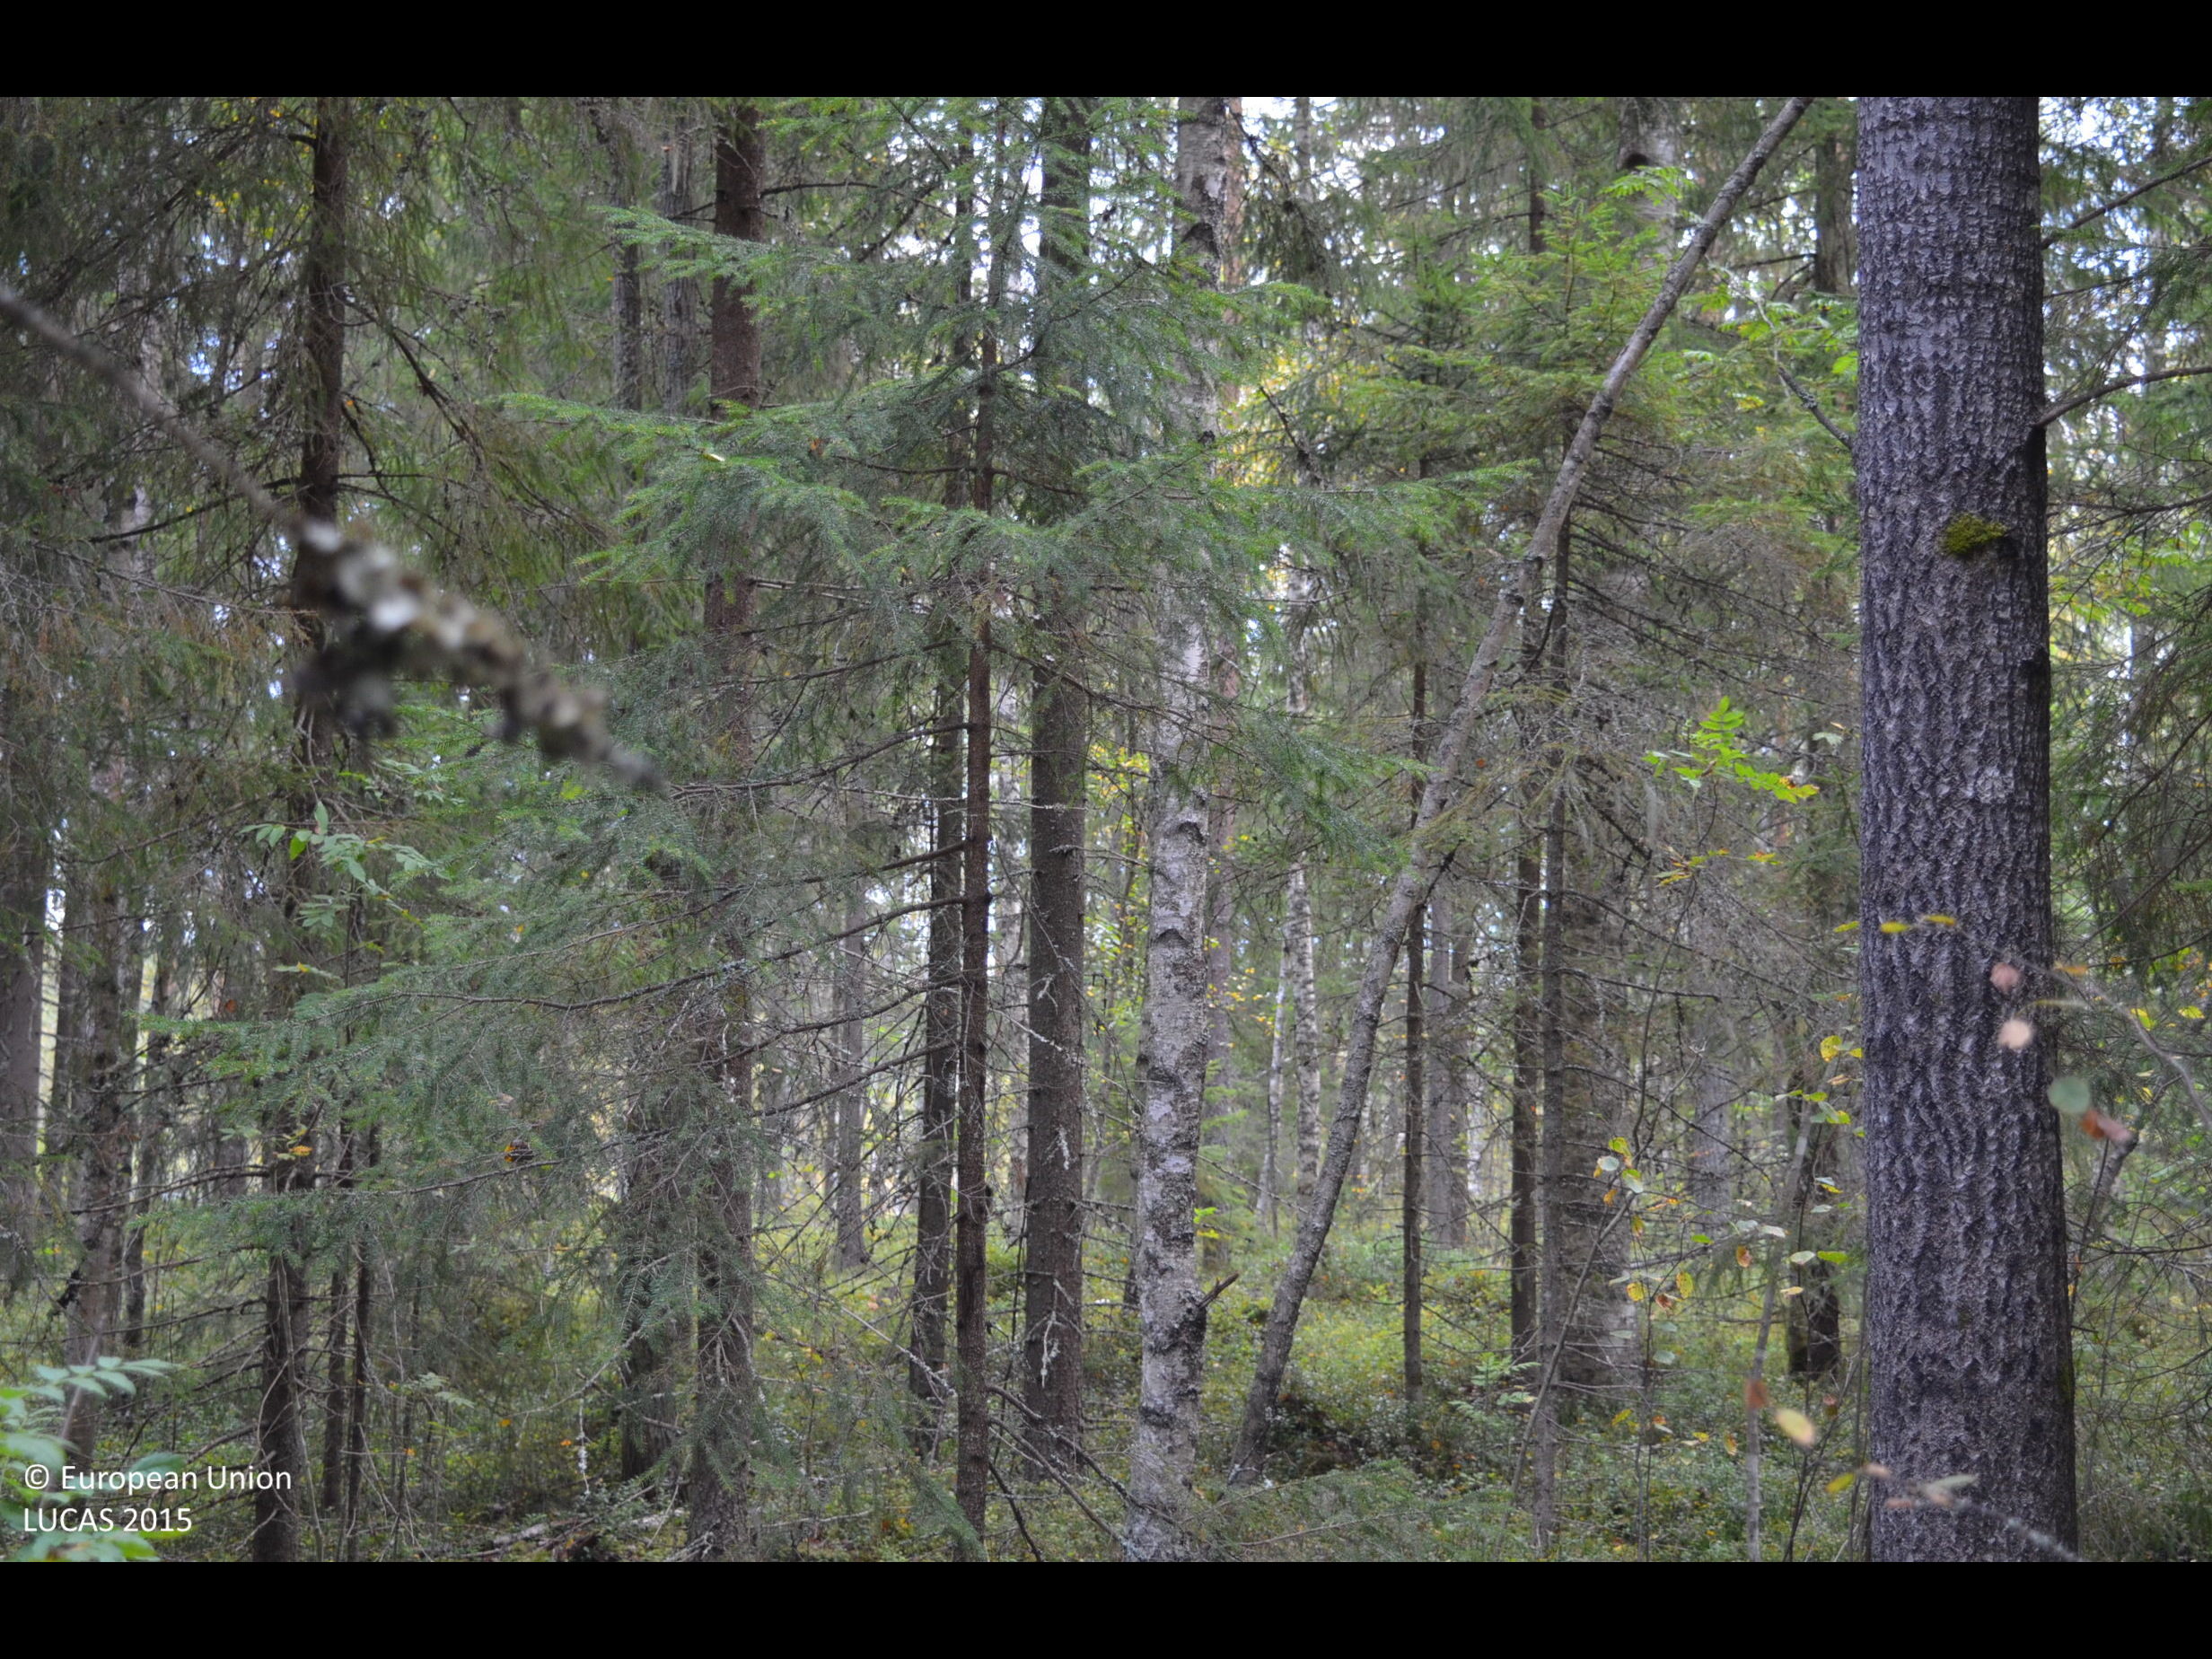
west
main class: Woodland
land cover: Spruce dominated mixed woodland
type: boreal forest
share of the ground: > 75 %
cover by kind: coniferous forest trees 50 %, broadleaved forest trees 25 %, shrubs 20 %, lichens and mosses 5 %
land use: Forestry
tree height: > 5 m
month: September
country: FI
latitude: 62.8276
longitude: 24.4734
